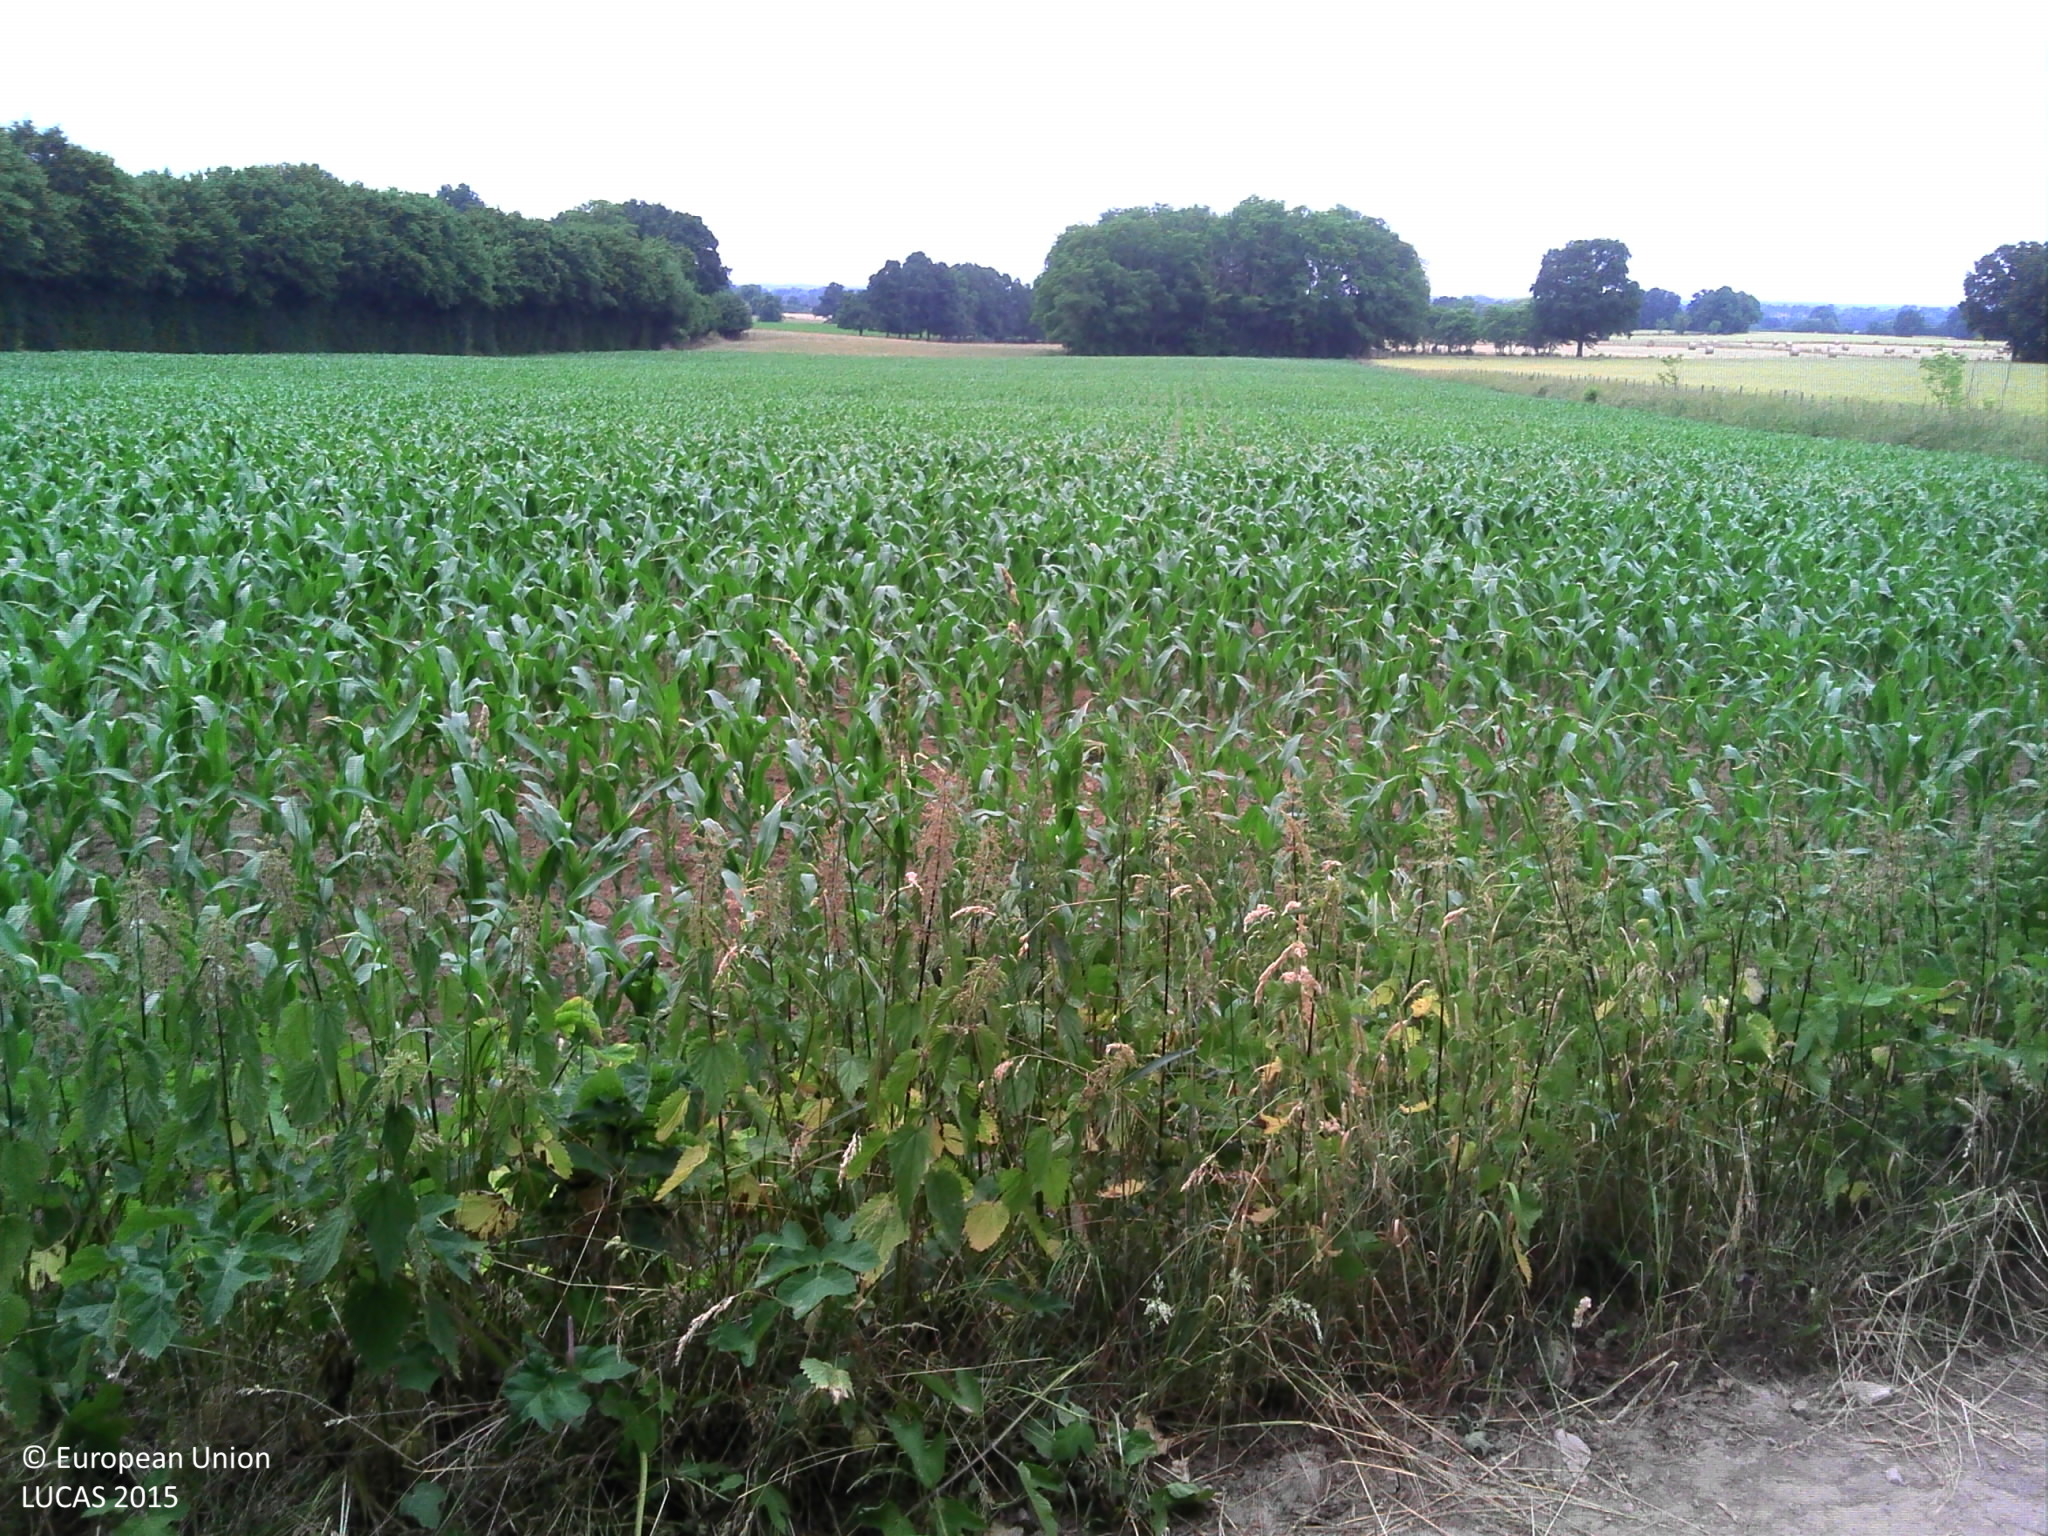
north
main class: Cropland
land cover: Rye
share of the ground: > 75 %
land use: Agriculture (excluding fallow land and kitchen gardens)
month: June
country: FR
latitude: 46.1940
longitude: 4.9102
